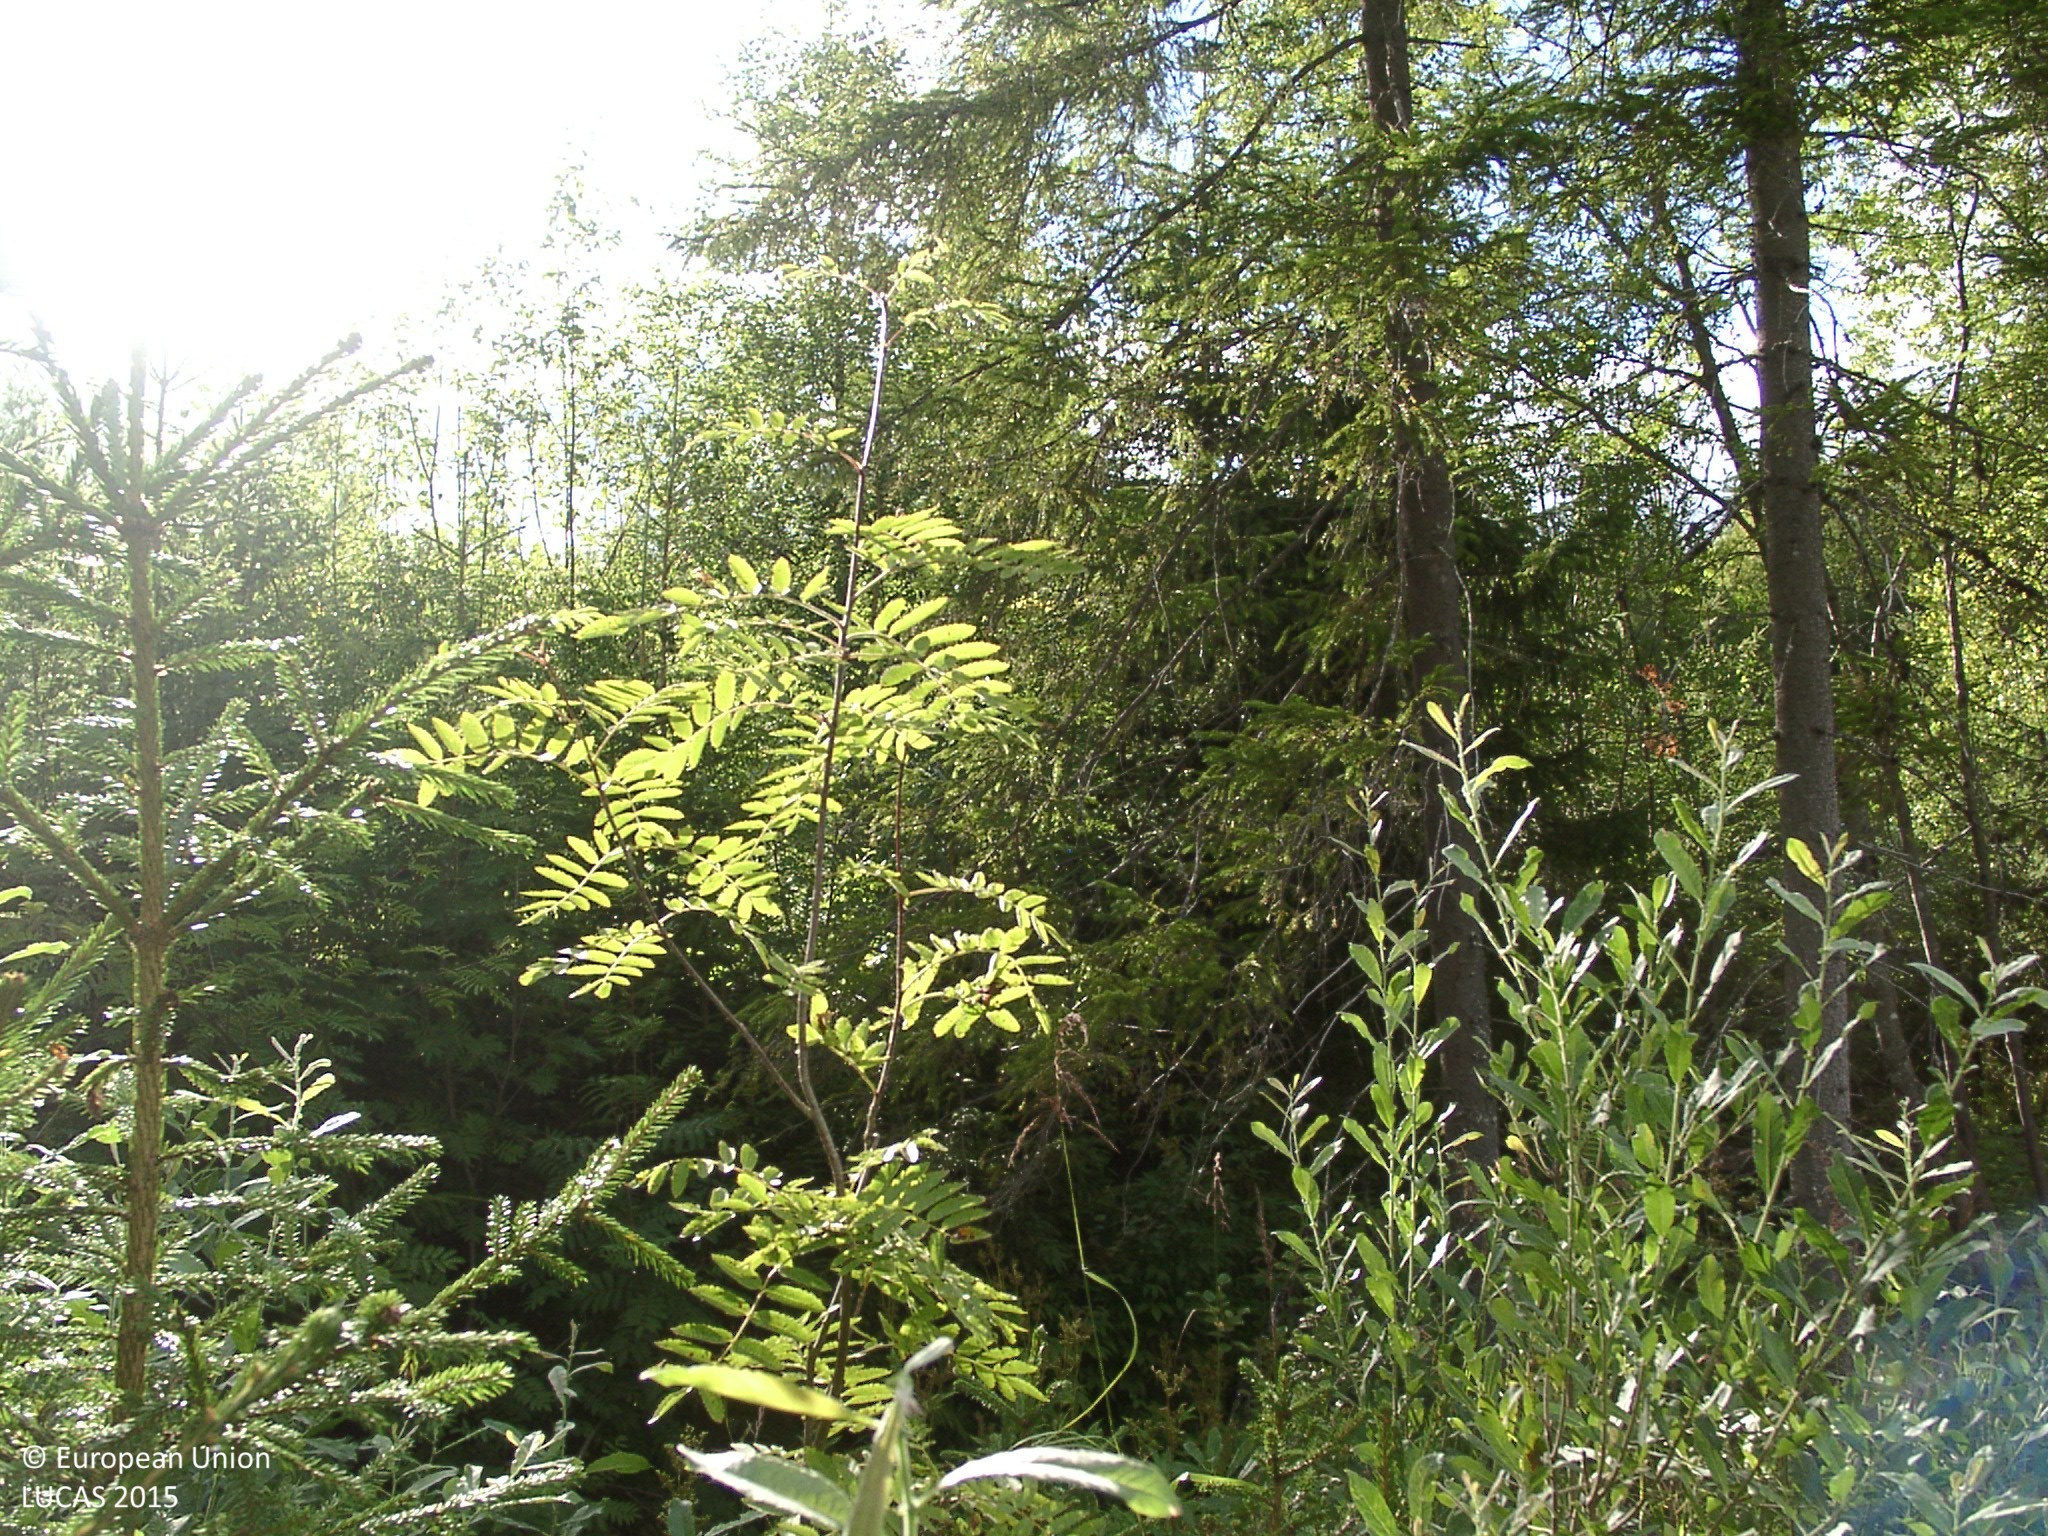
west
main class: Woodland
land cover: Broadleaved woodland
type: boreal forest
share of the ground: 25 - 50 %
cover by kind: shrubs 40 %, herbaceous plants 30 %, broadleaved forest trees 25 %, coniferous forest trees 5 %
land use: Forestry
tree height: < 5 m
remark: Nursery
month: August
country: FI
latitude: 62.3681
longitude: 25.5570
